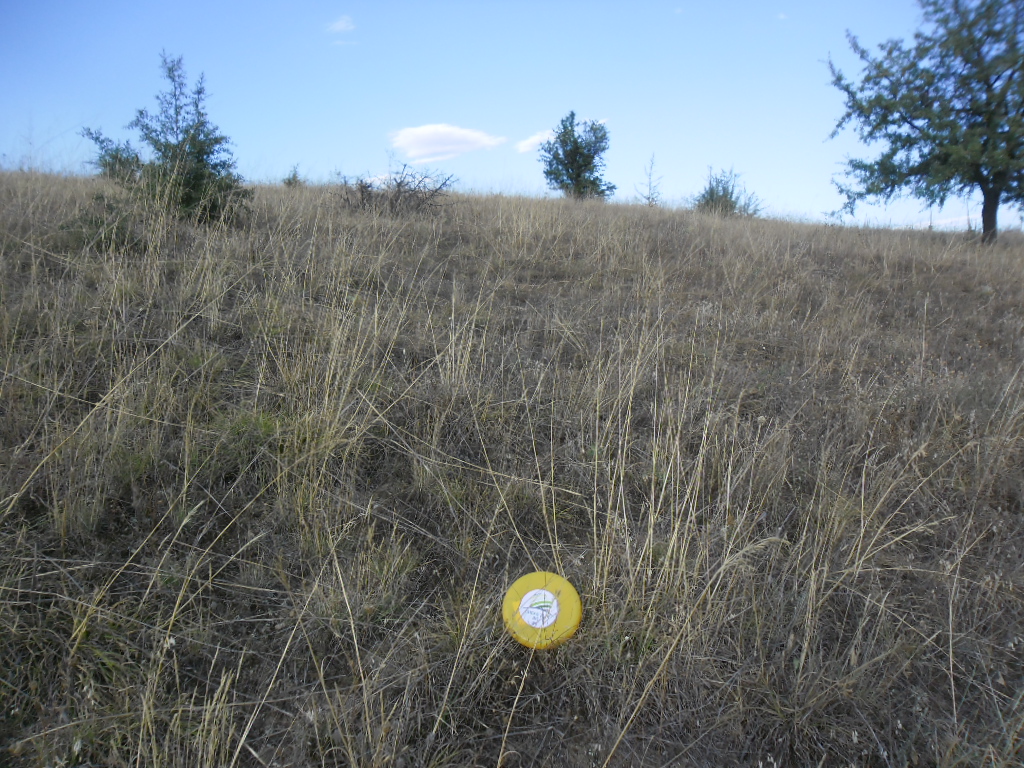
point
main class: Grassland
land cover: Grassland with sparse tree/shrub cover
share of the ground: > 75 %
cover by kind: herbaceous plants 90 %, broadleaved forest trees 5 %, shrubs 5 %
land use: Agriculture (excluding fallow land and kitchen gardens)
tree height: < 5 m
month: August
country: BG
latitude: 42.0336
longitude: 22.9839
